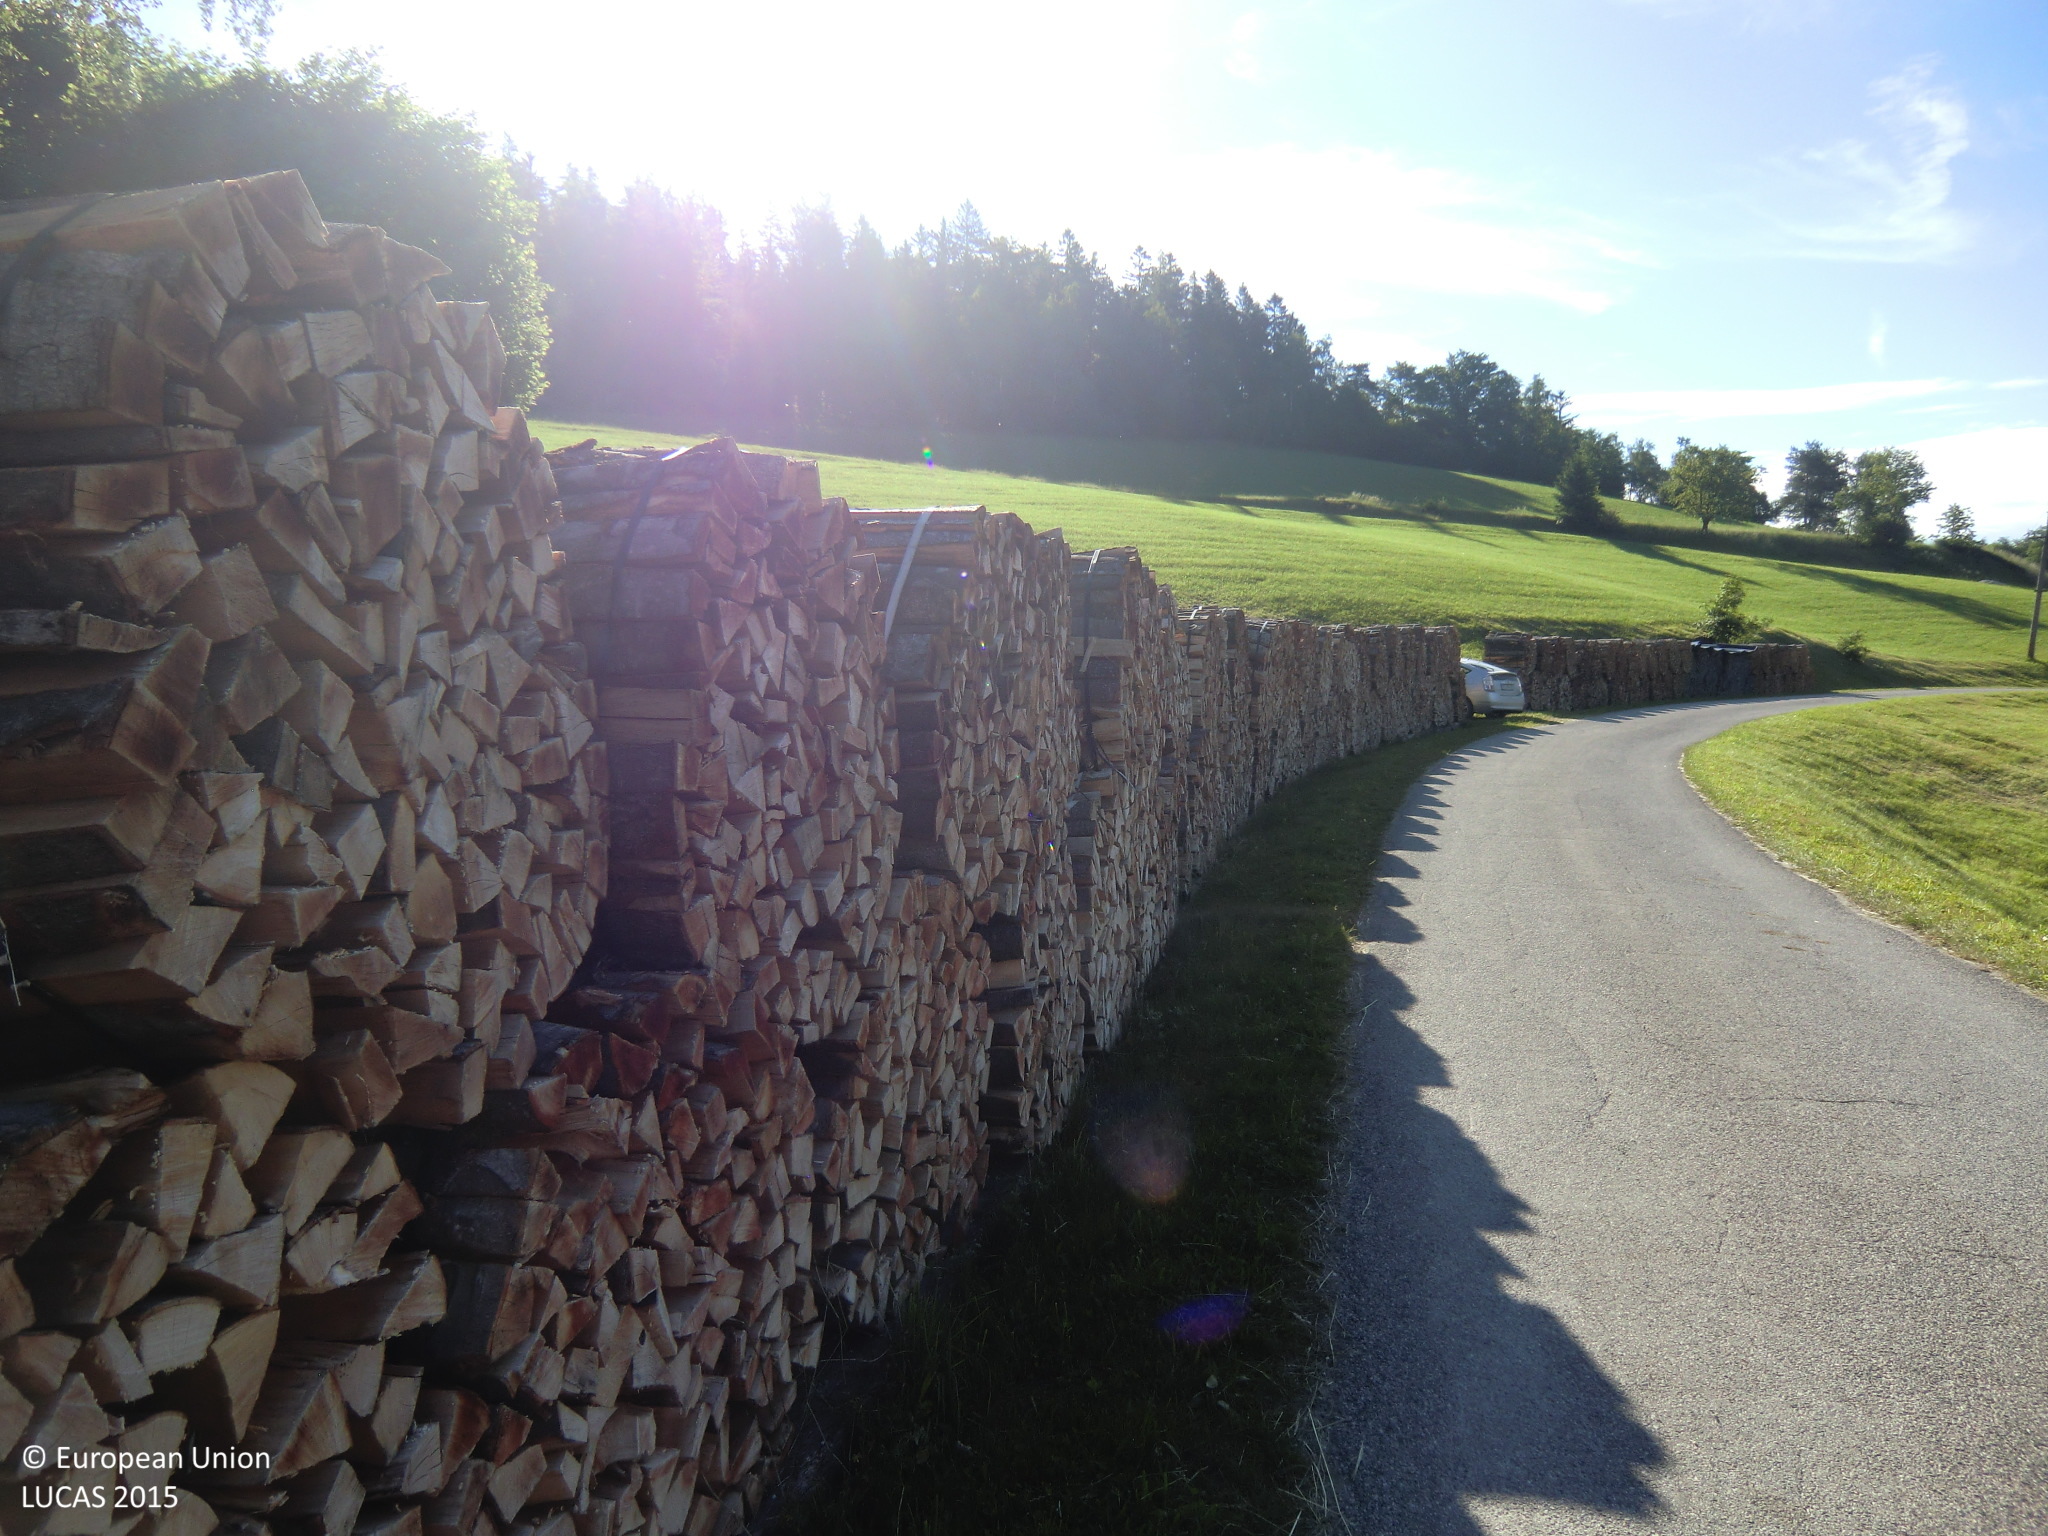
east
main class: Grassland
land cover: Grassland without tree/shrub cover
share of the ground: > 75 %
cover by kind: herbaceous plants 100 %
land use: Agriculture (excluding fallow land and kitchen gardens)
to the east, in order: Paved roads, cycling and walking lanes; Grass margins; Artificial constructions; Grassland without tree/shrub cover; Temporary grasslands; Spruce dominated mixed woodland; Tracks; Spruce dominated mixed woodland; Tracks; Spruce dominated mixed woodland
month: June
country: AT
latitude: 48.2736
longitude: 14.9731
